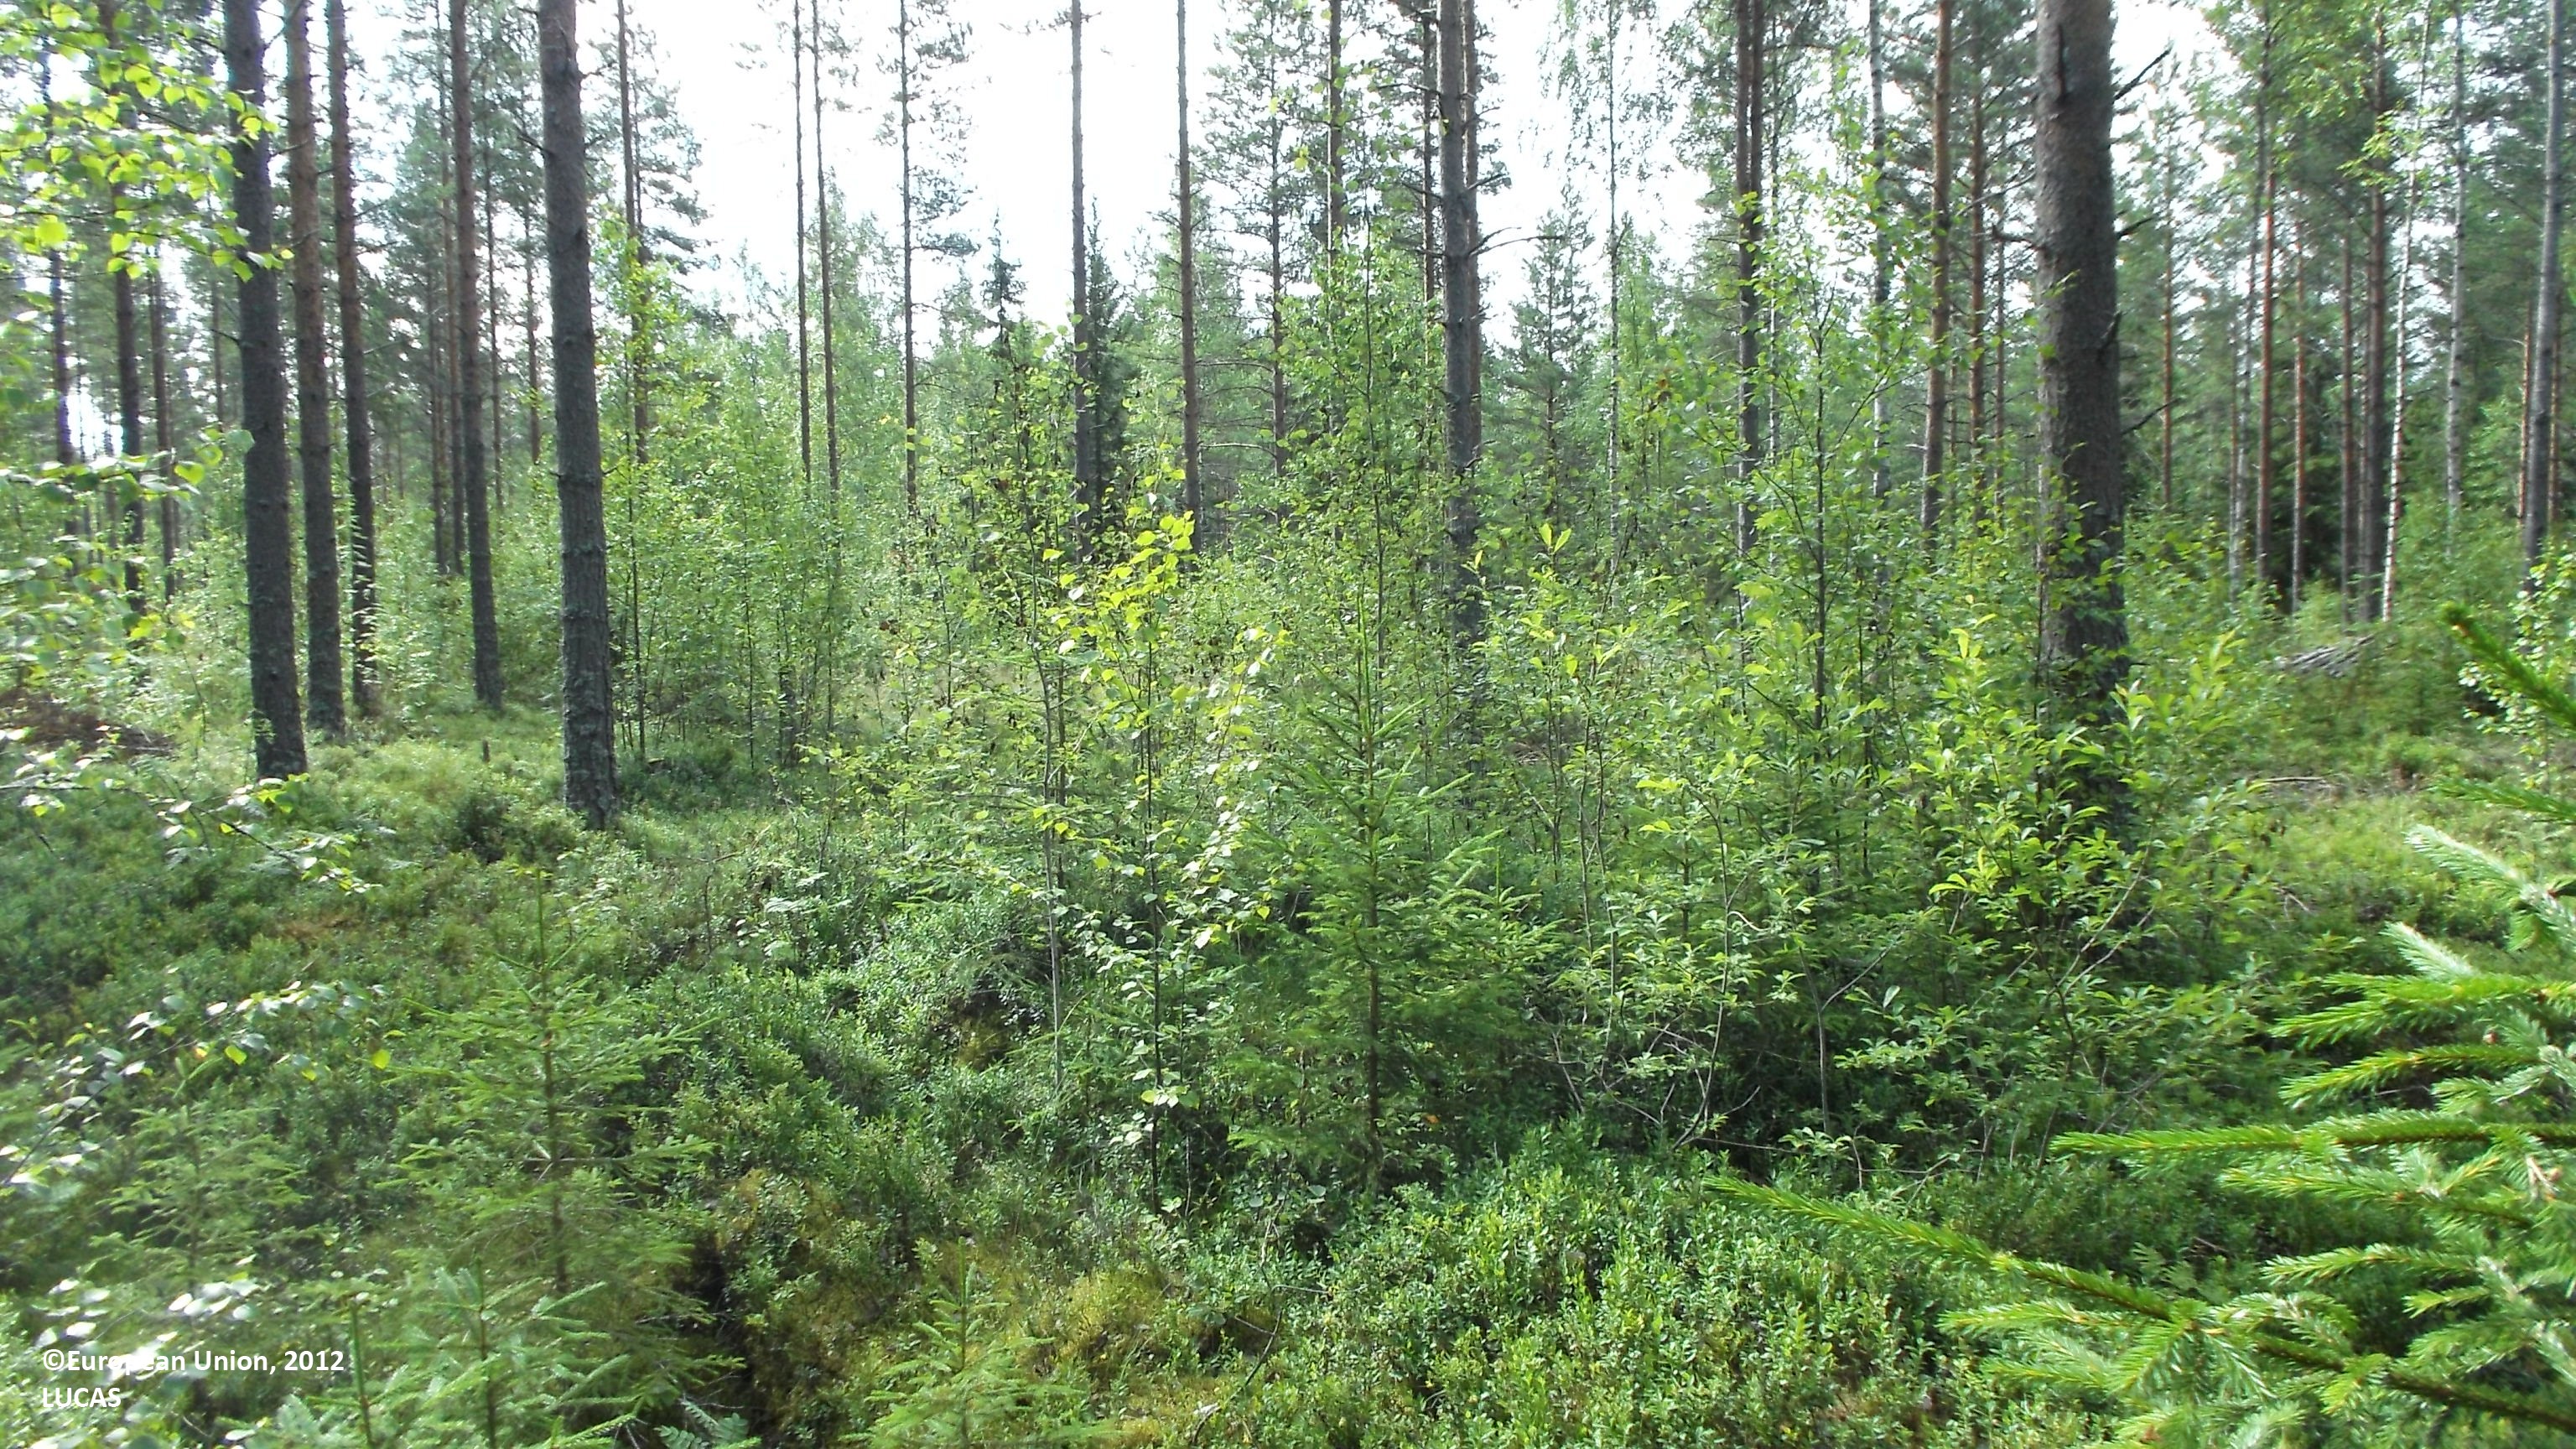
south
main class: Woodland
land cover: Other mixed woodland
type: boreal forest
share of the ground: 25 - 50 %
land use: Forestry
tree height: > 5 m
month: July
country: FI
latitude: 63.4880
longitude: 23.6993
